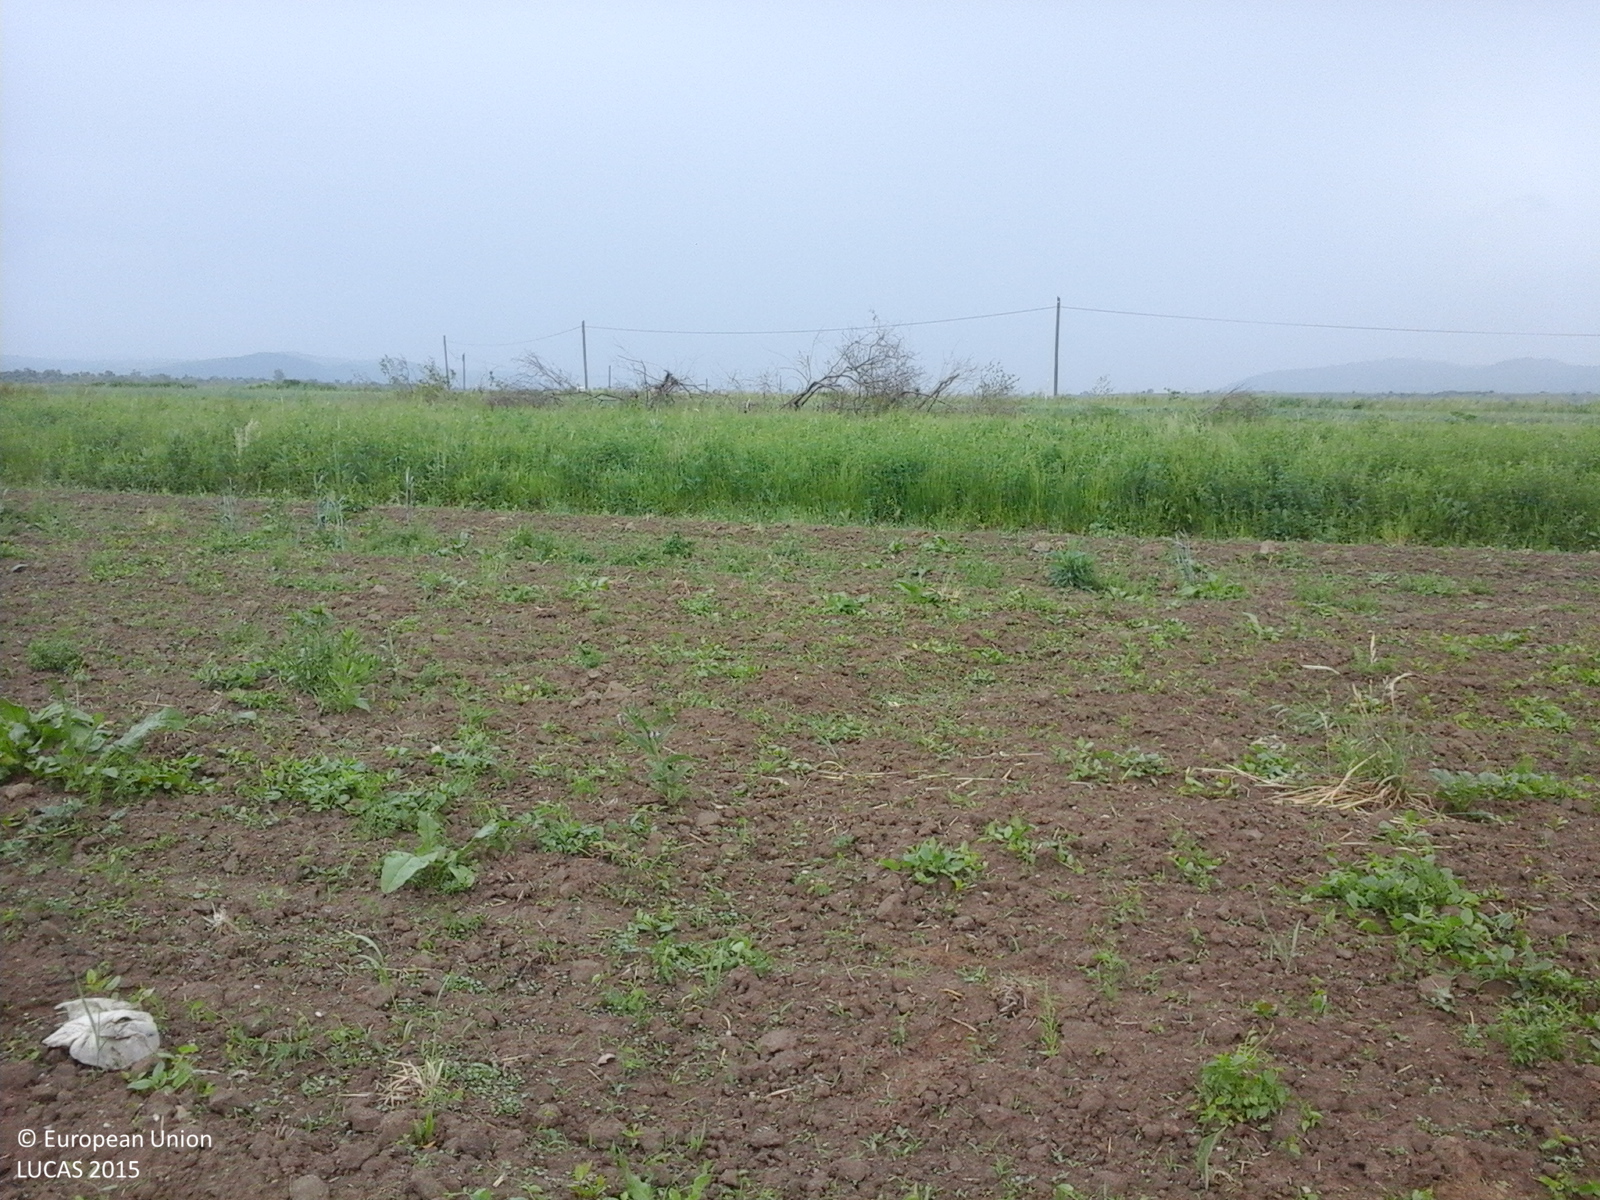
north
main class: Cropland
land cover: Lucerne
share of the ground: 10 - 25 %
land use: Agriculture (excluding fallow land and kitchen gardens)
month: May
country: RO
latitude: 45.8782
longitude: 25.2106
